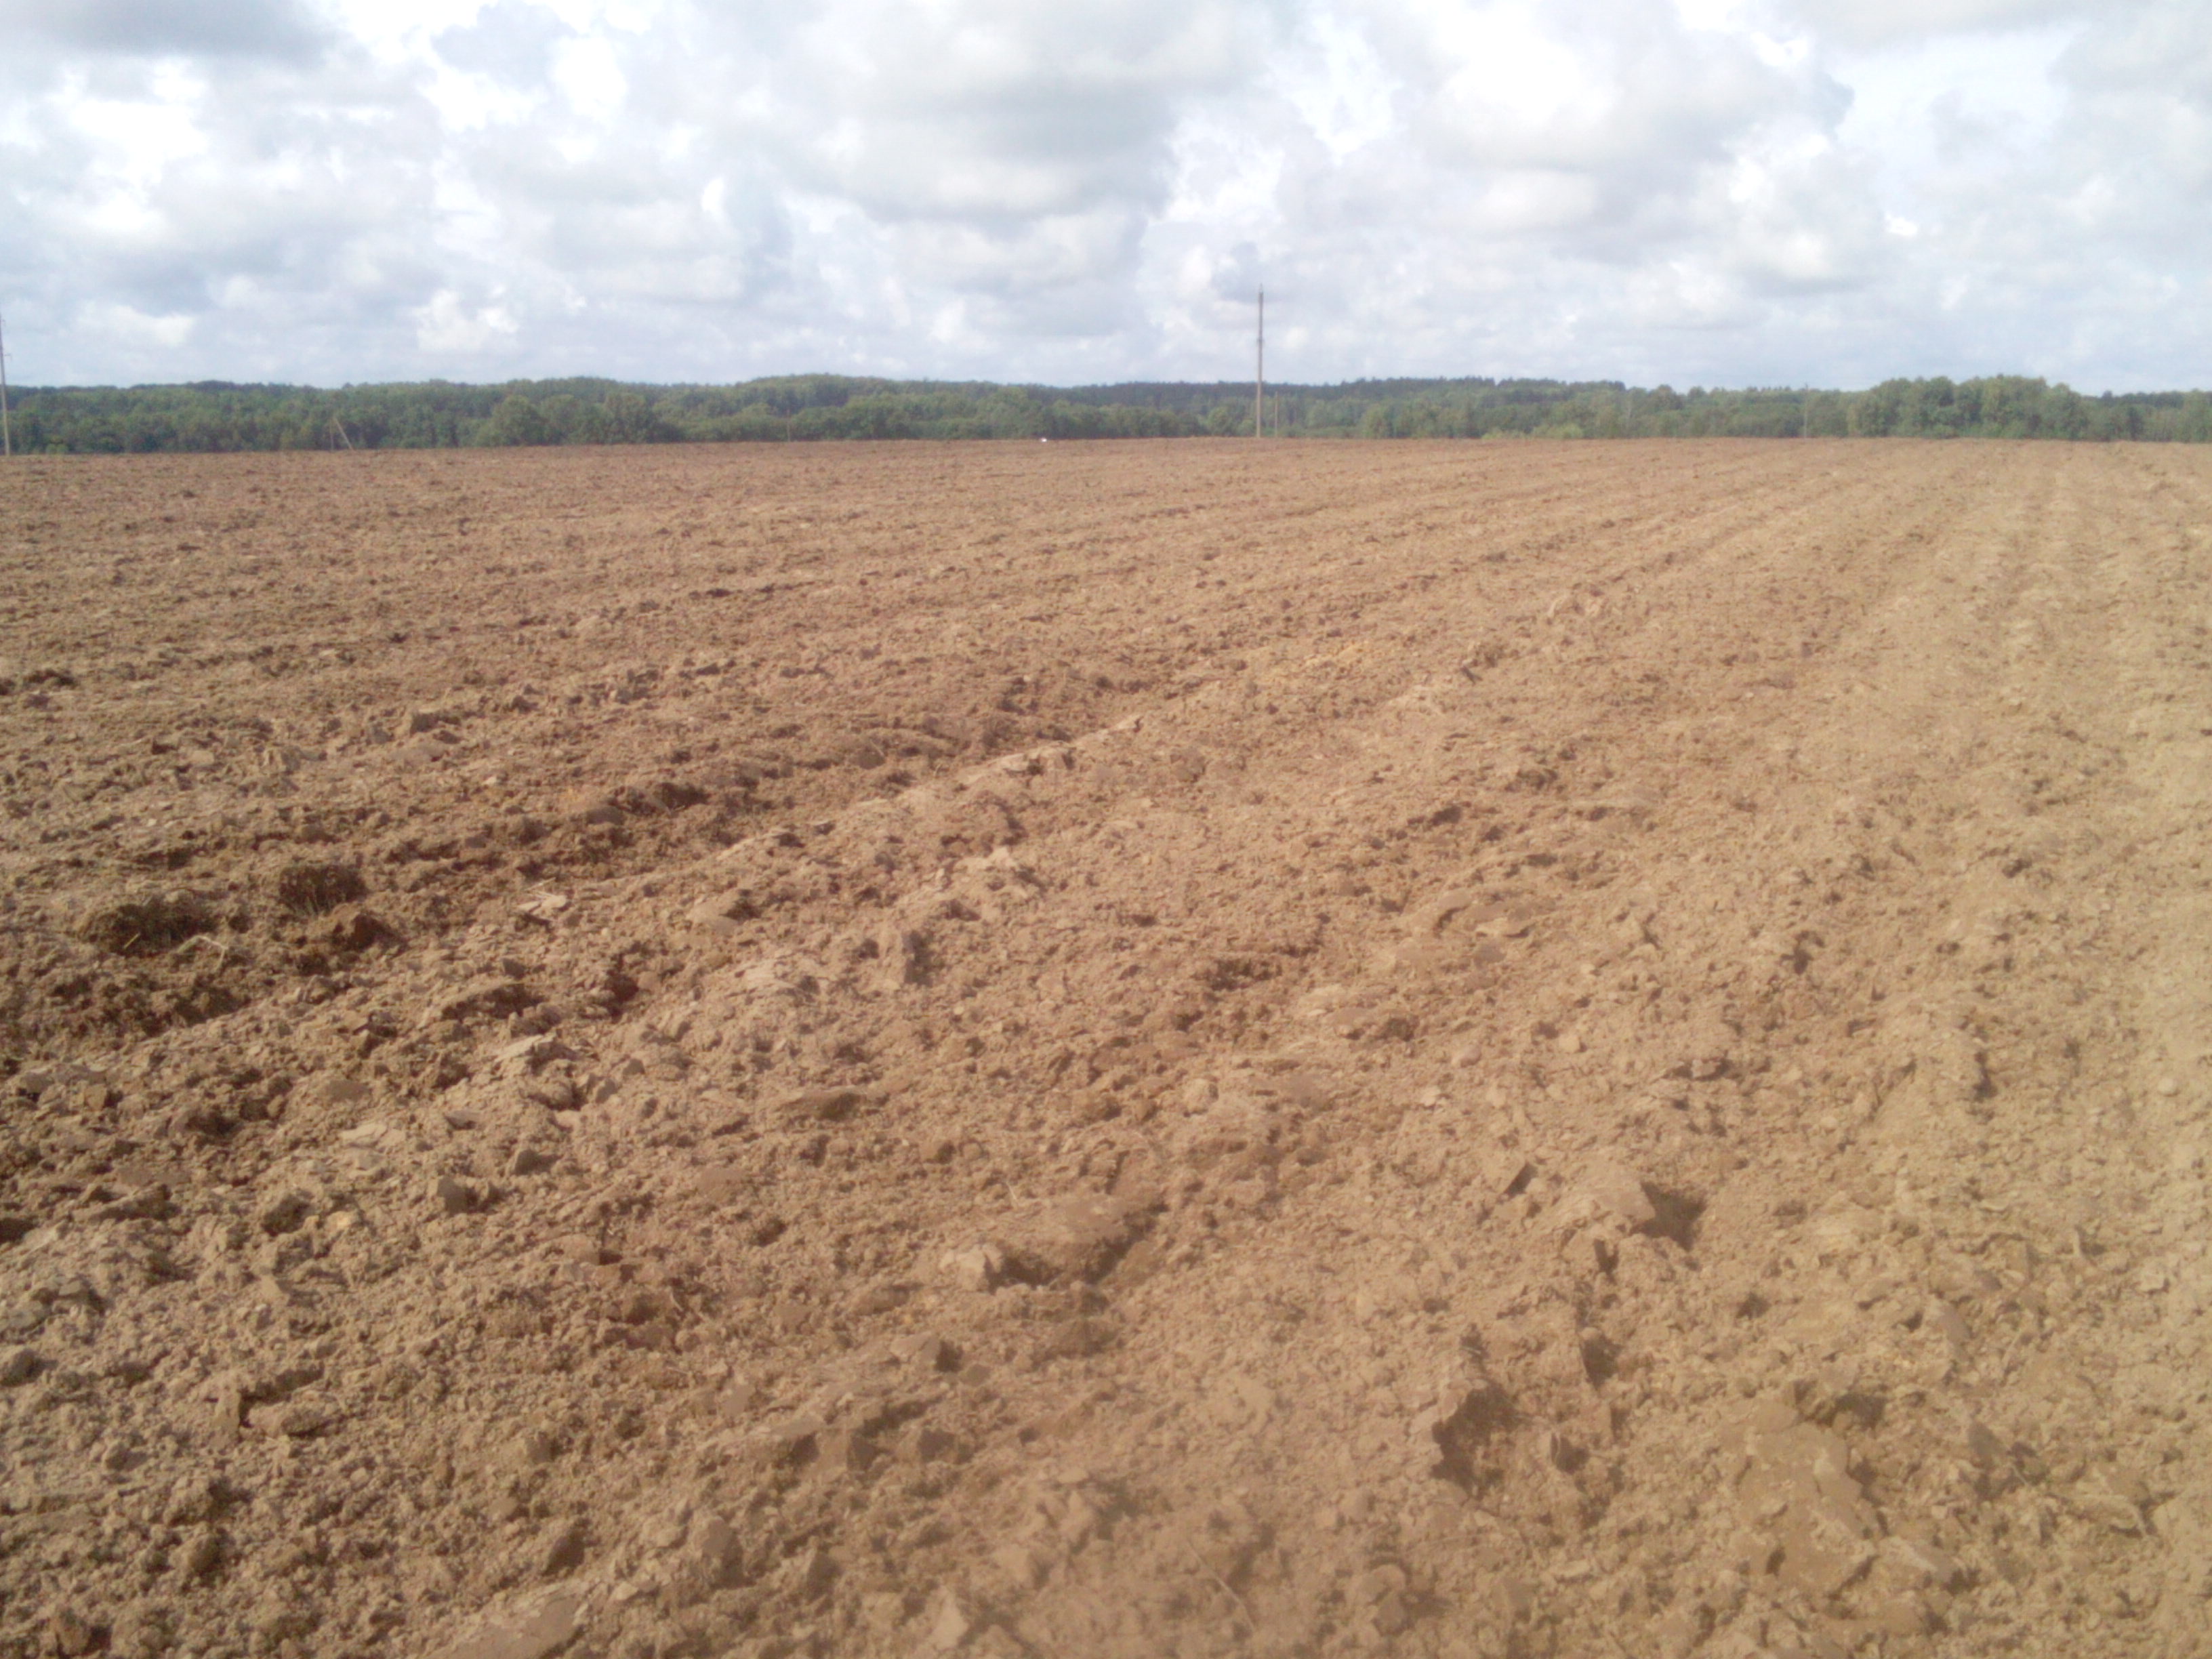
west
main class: Cropland
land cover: Common wheat
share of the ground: < 10 %
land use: Agriculture (excluding fallow land and kitchen gardens)
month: September
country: LT
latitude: 55.9027
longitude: 22.4871
